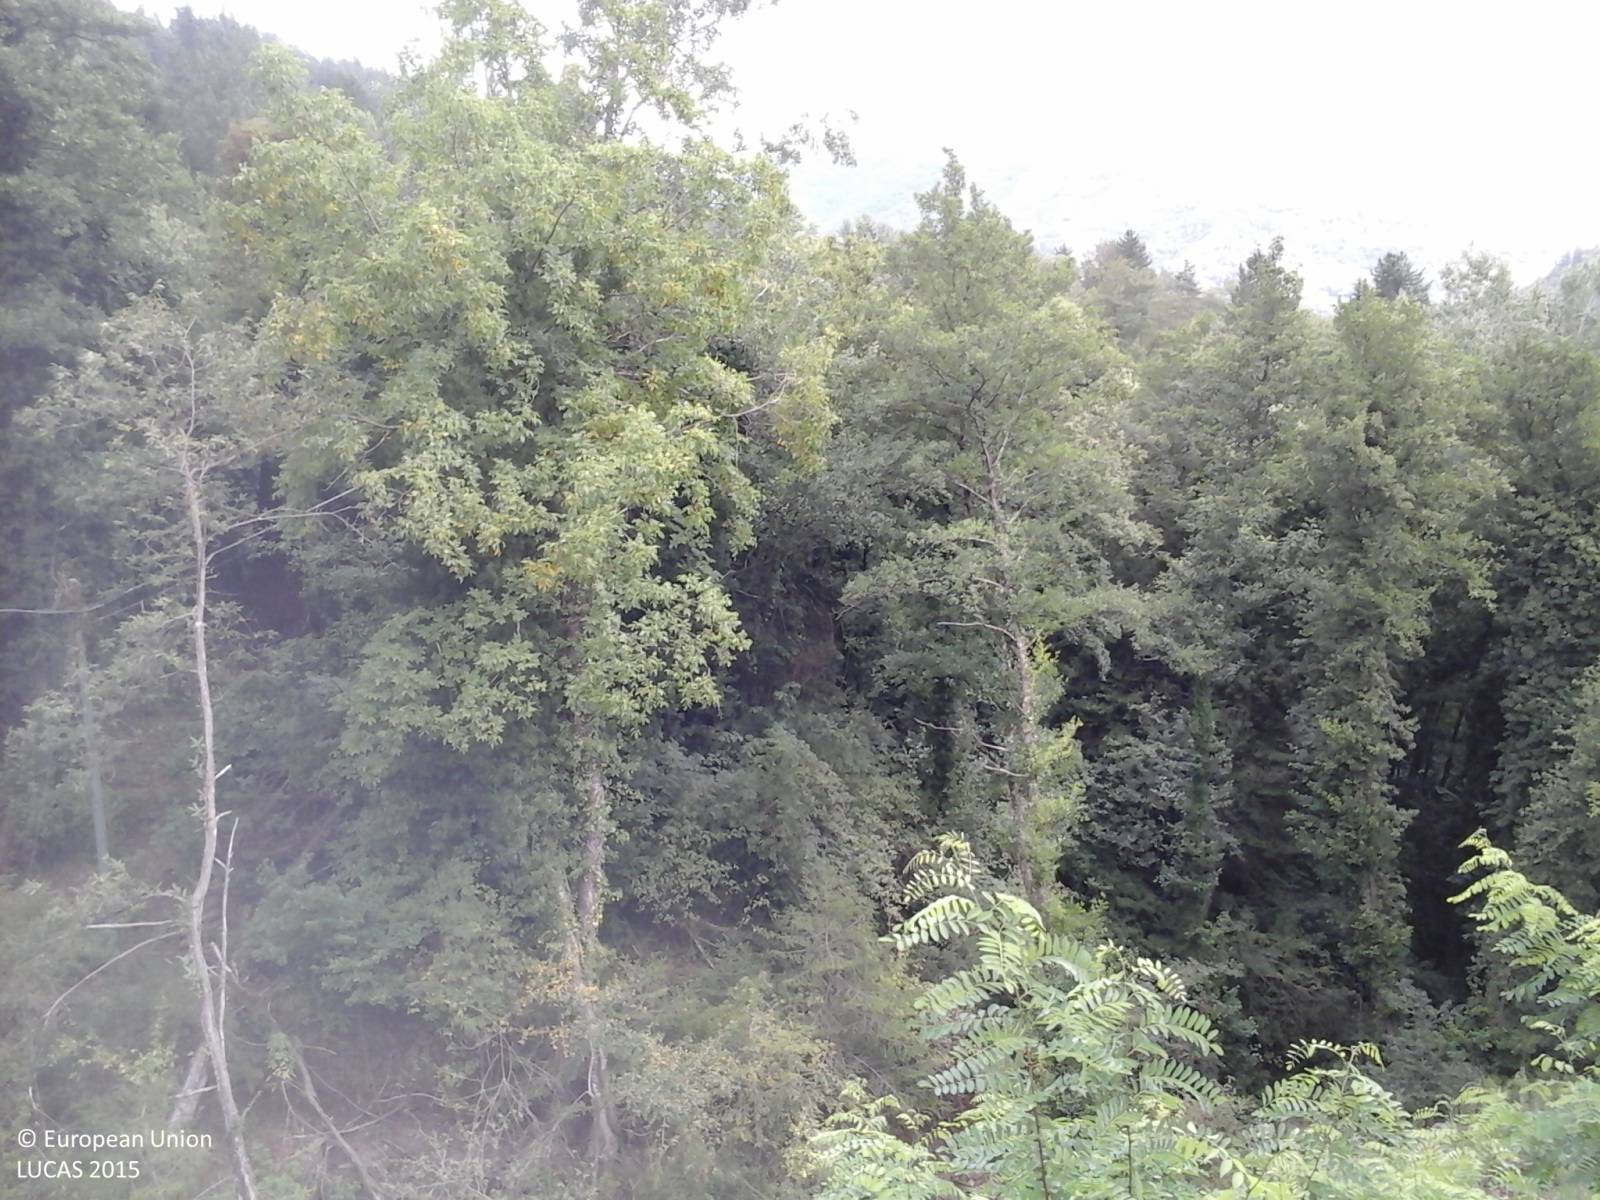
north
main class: Woodland
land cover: Broadleaved woodland
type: thermophilous deciduous forest
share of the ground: > 75 %
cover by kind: broadleaved forest trees 95 %, shrubs 5 %
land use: Forestry
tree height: > 5 m
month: August
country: IT
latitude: 43.7236
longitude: 11.6715
